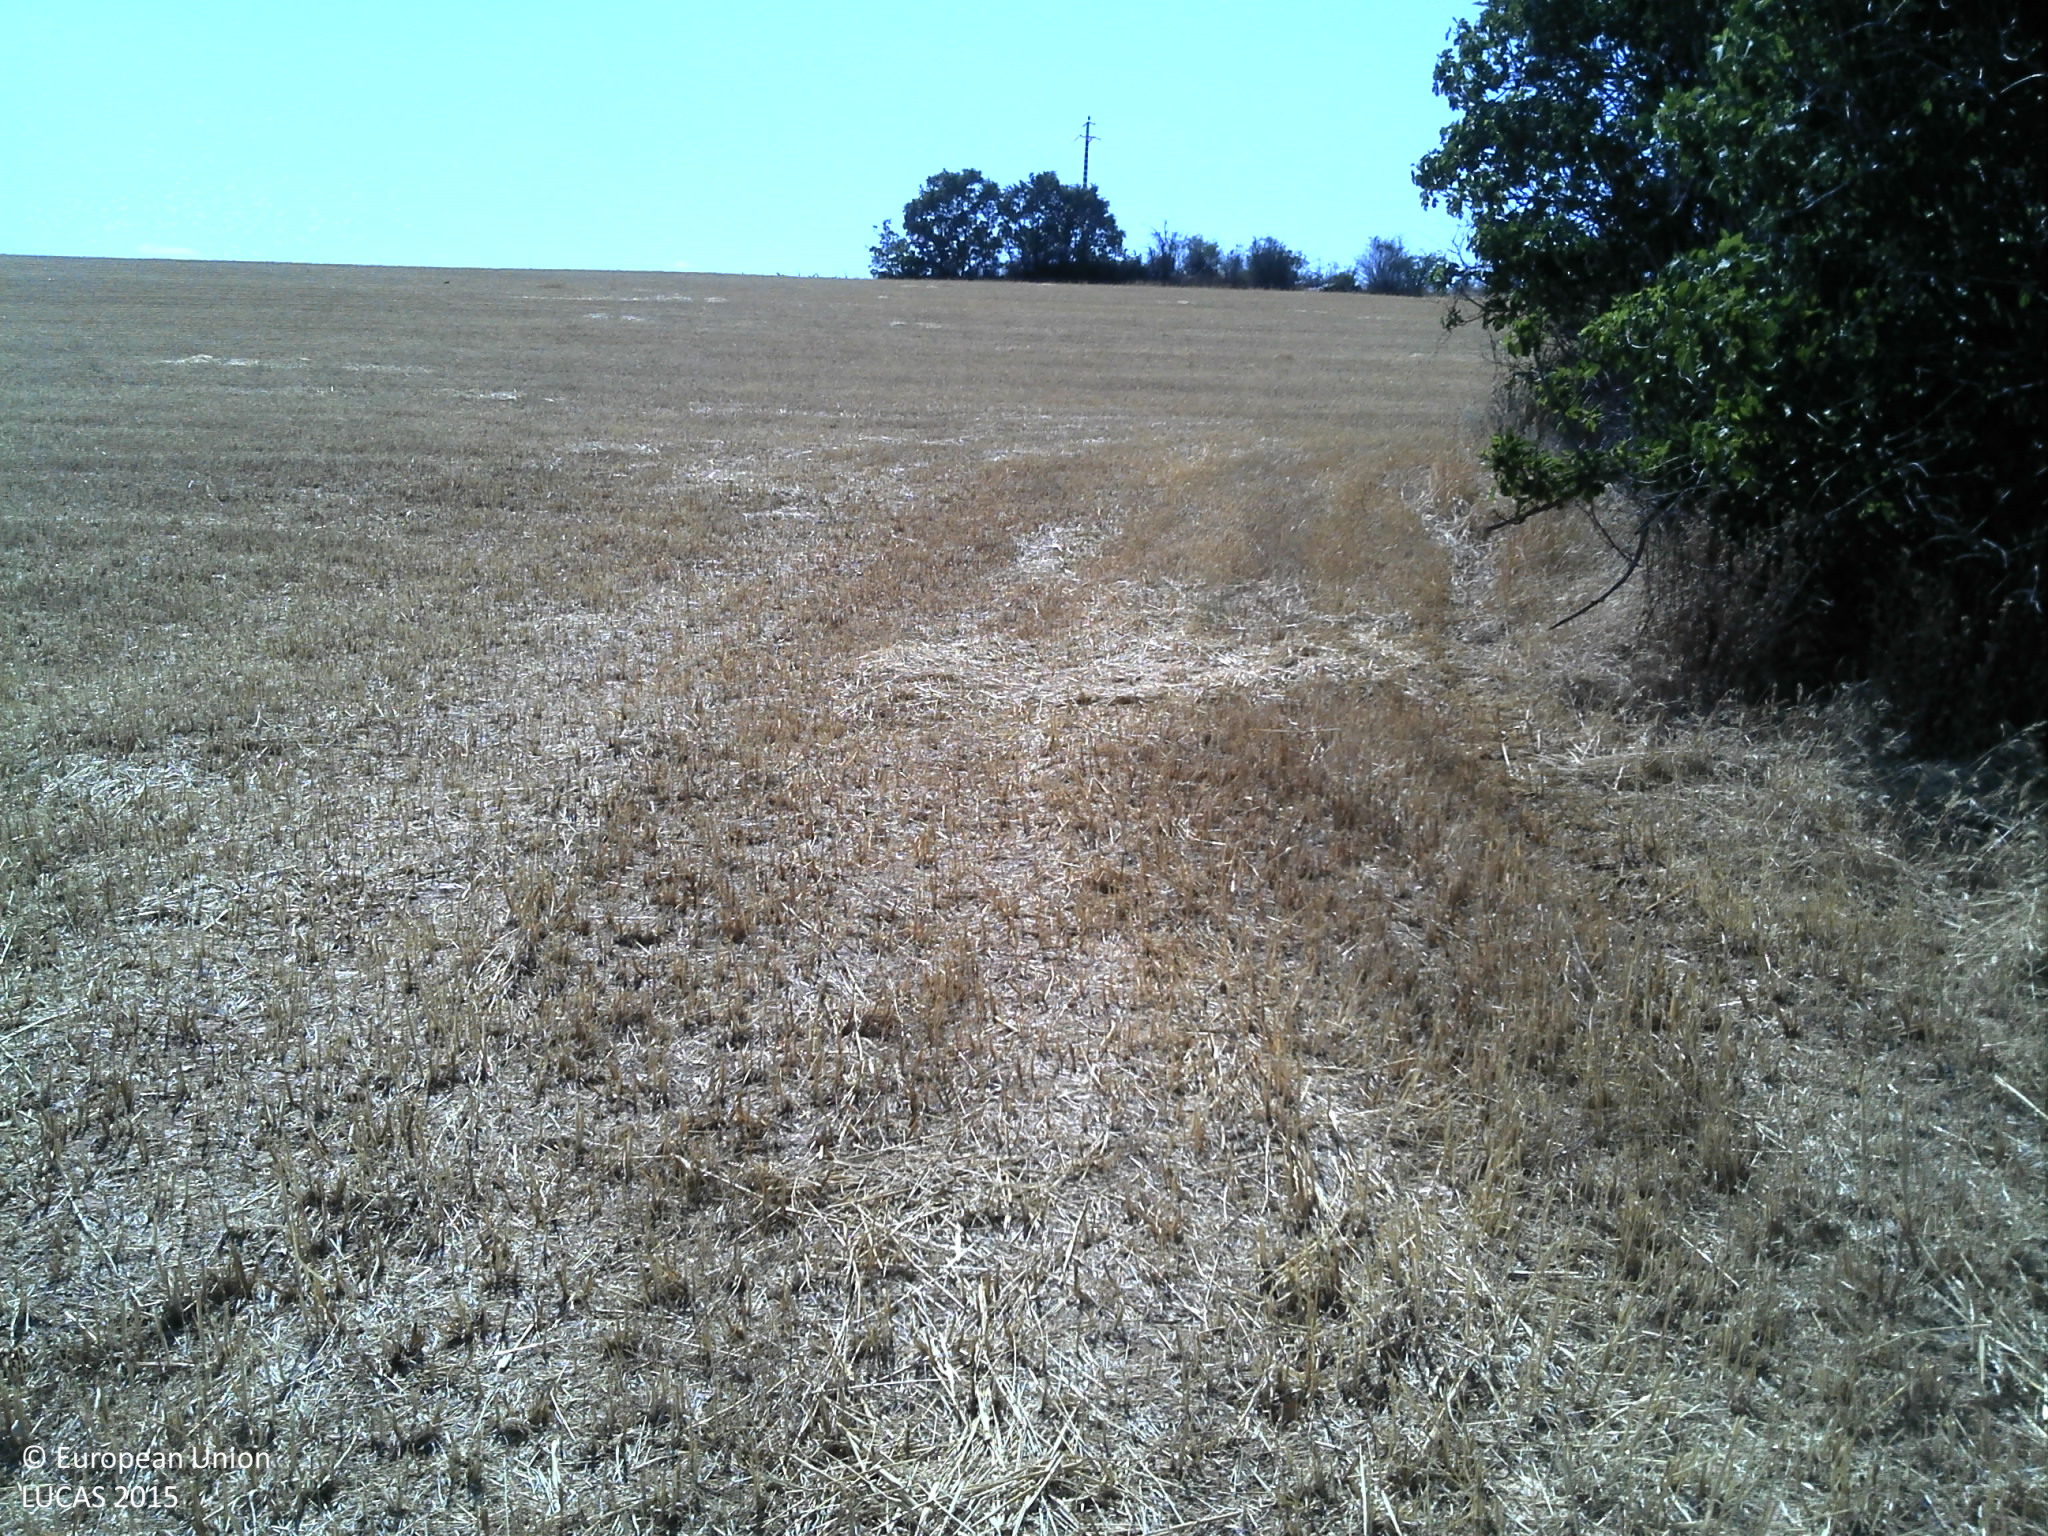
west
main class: Cropland
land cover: Oats
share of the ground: > 75 %
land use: Agriculture (excluding fallow land and kitchen gardens)
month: June
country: PT
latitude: 40.8164
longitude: -6.9011
